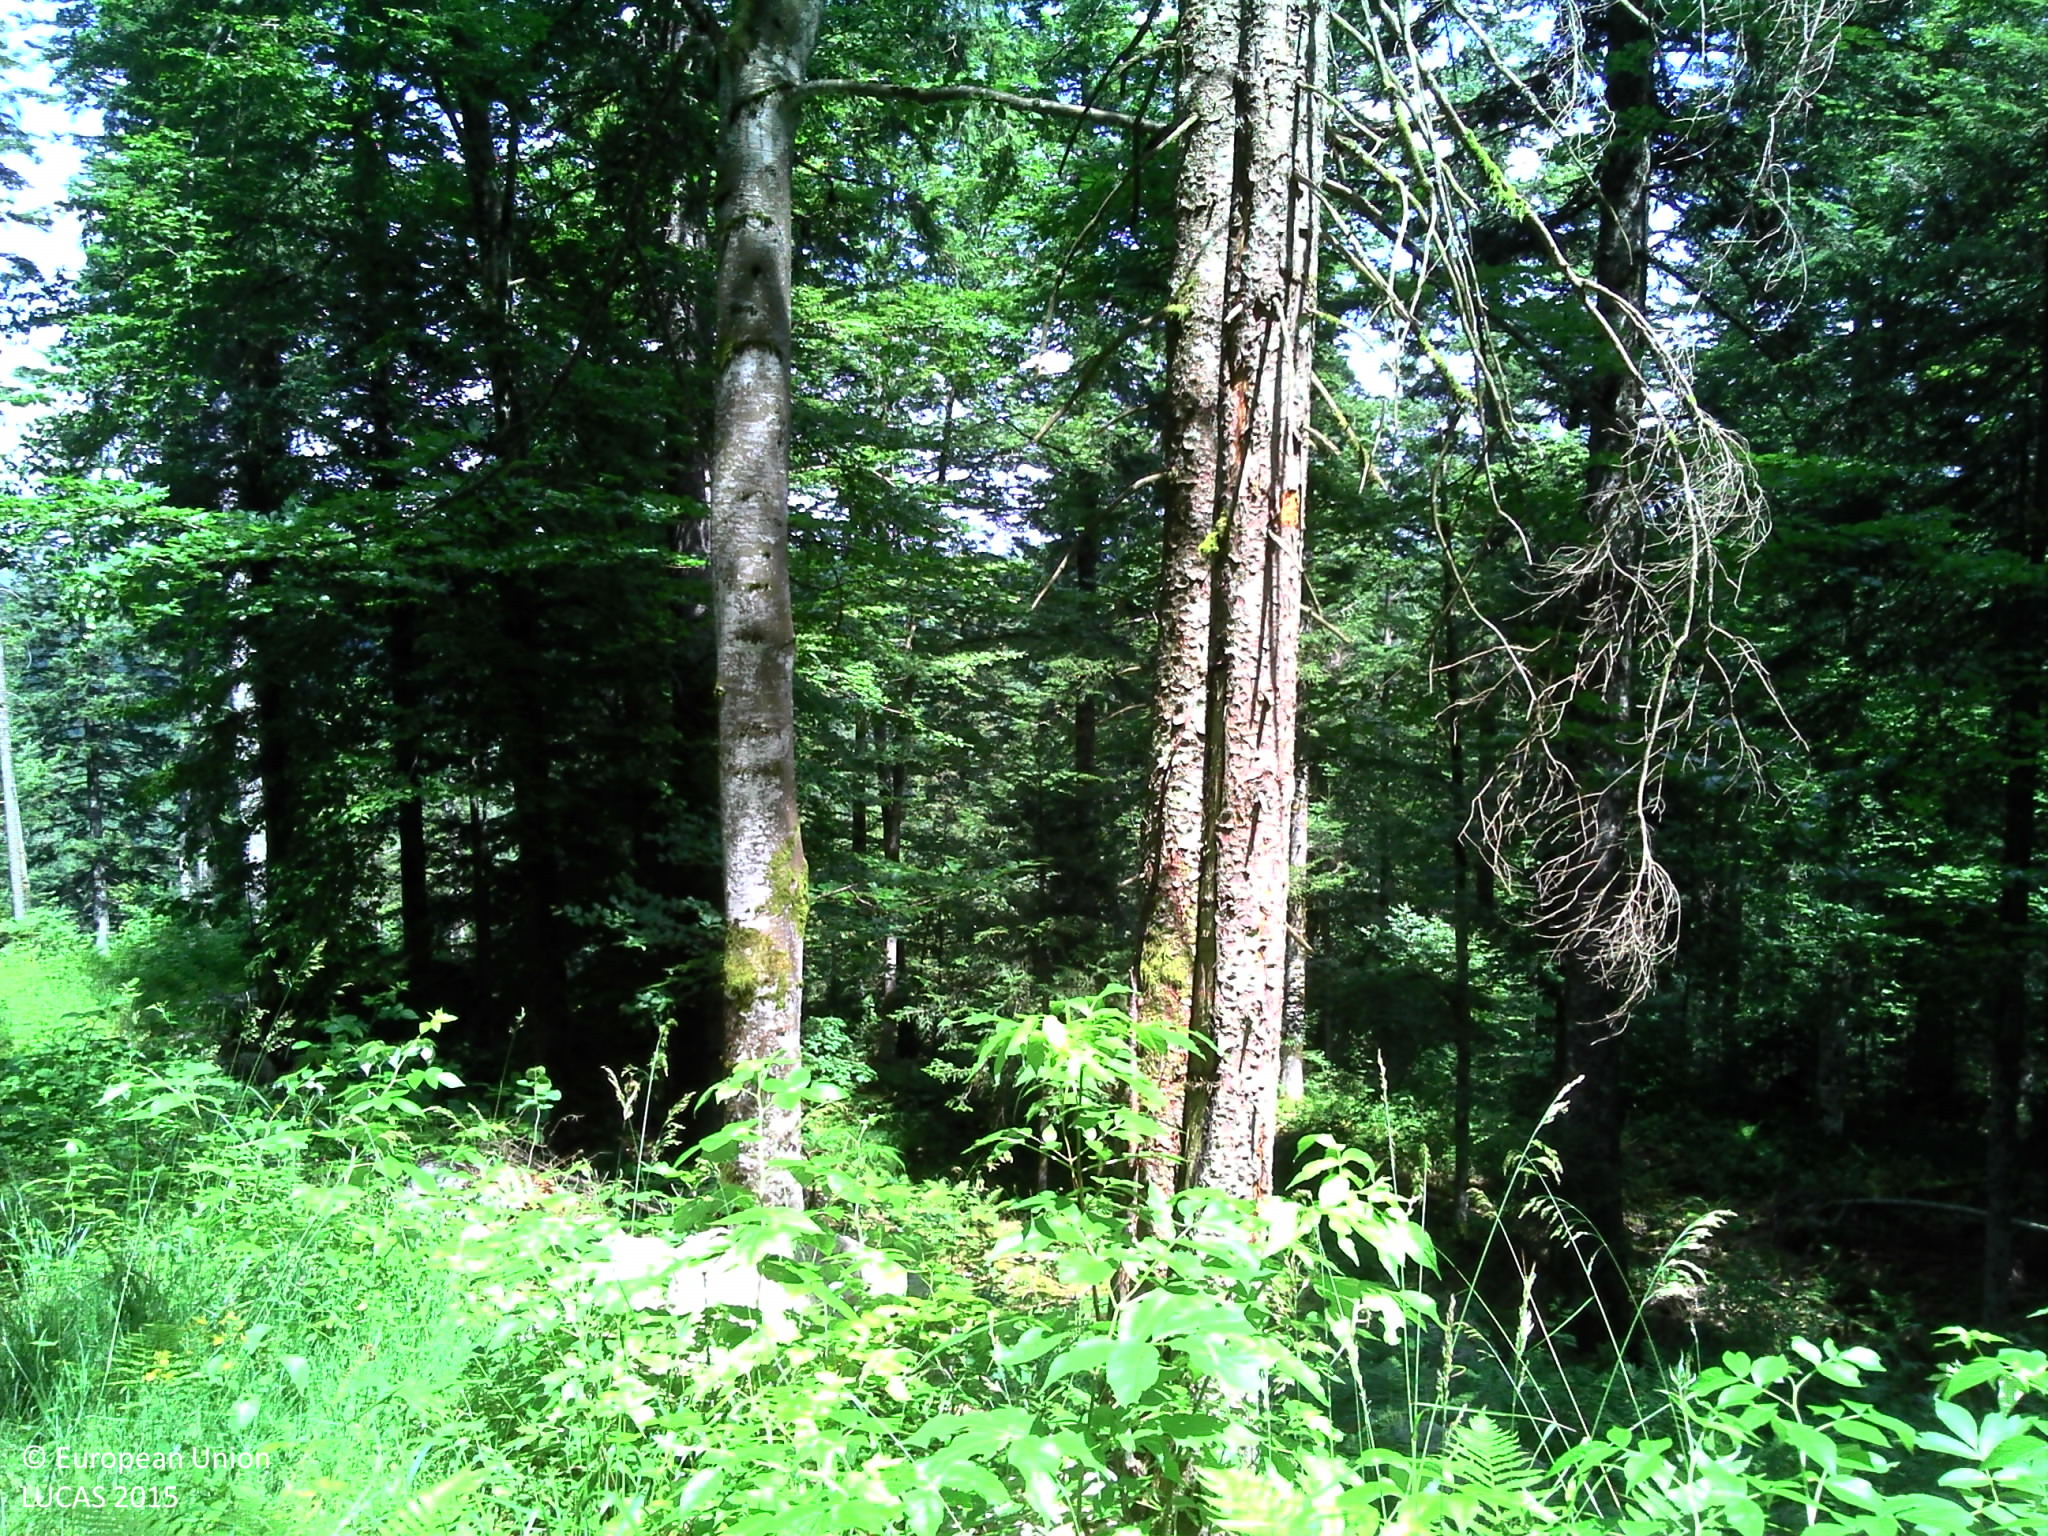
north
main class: Woodland
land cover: Spruce dominated mixed woodland
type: mountainous beech forest
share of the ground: > 75 %
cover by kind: coniferous forest trees 30 %, broadleaved forest trees 30 %, shrubs 10 %, herbaceous plants 10 %, lichens and mosses 10 %, consolidated bare surface 10 %
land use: Forestry
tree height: > 5 m
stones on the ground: > 50 %
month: July
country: FR
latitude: 46.7324
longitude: 6.1422
